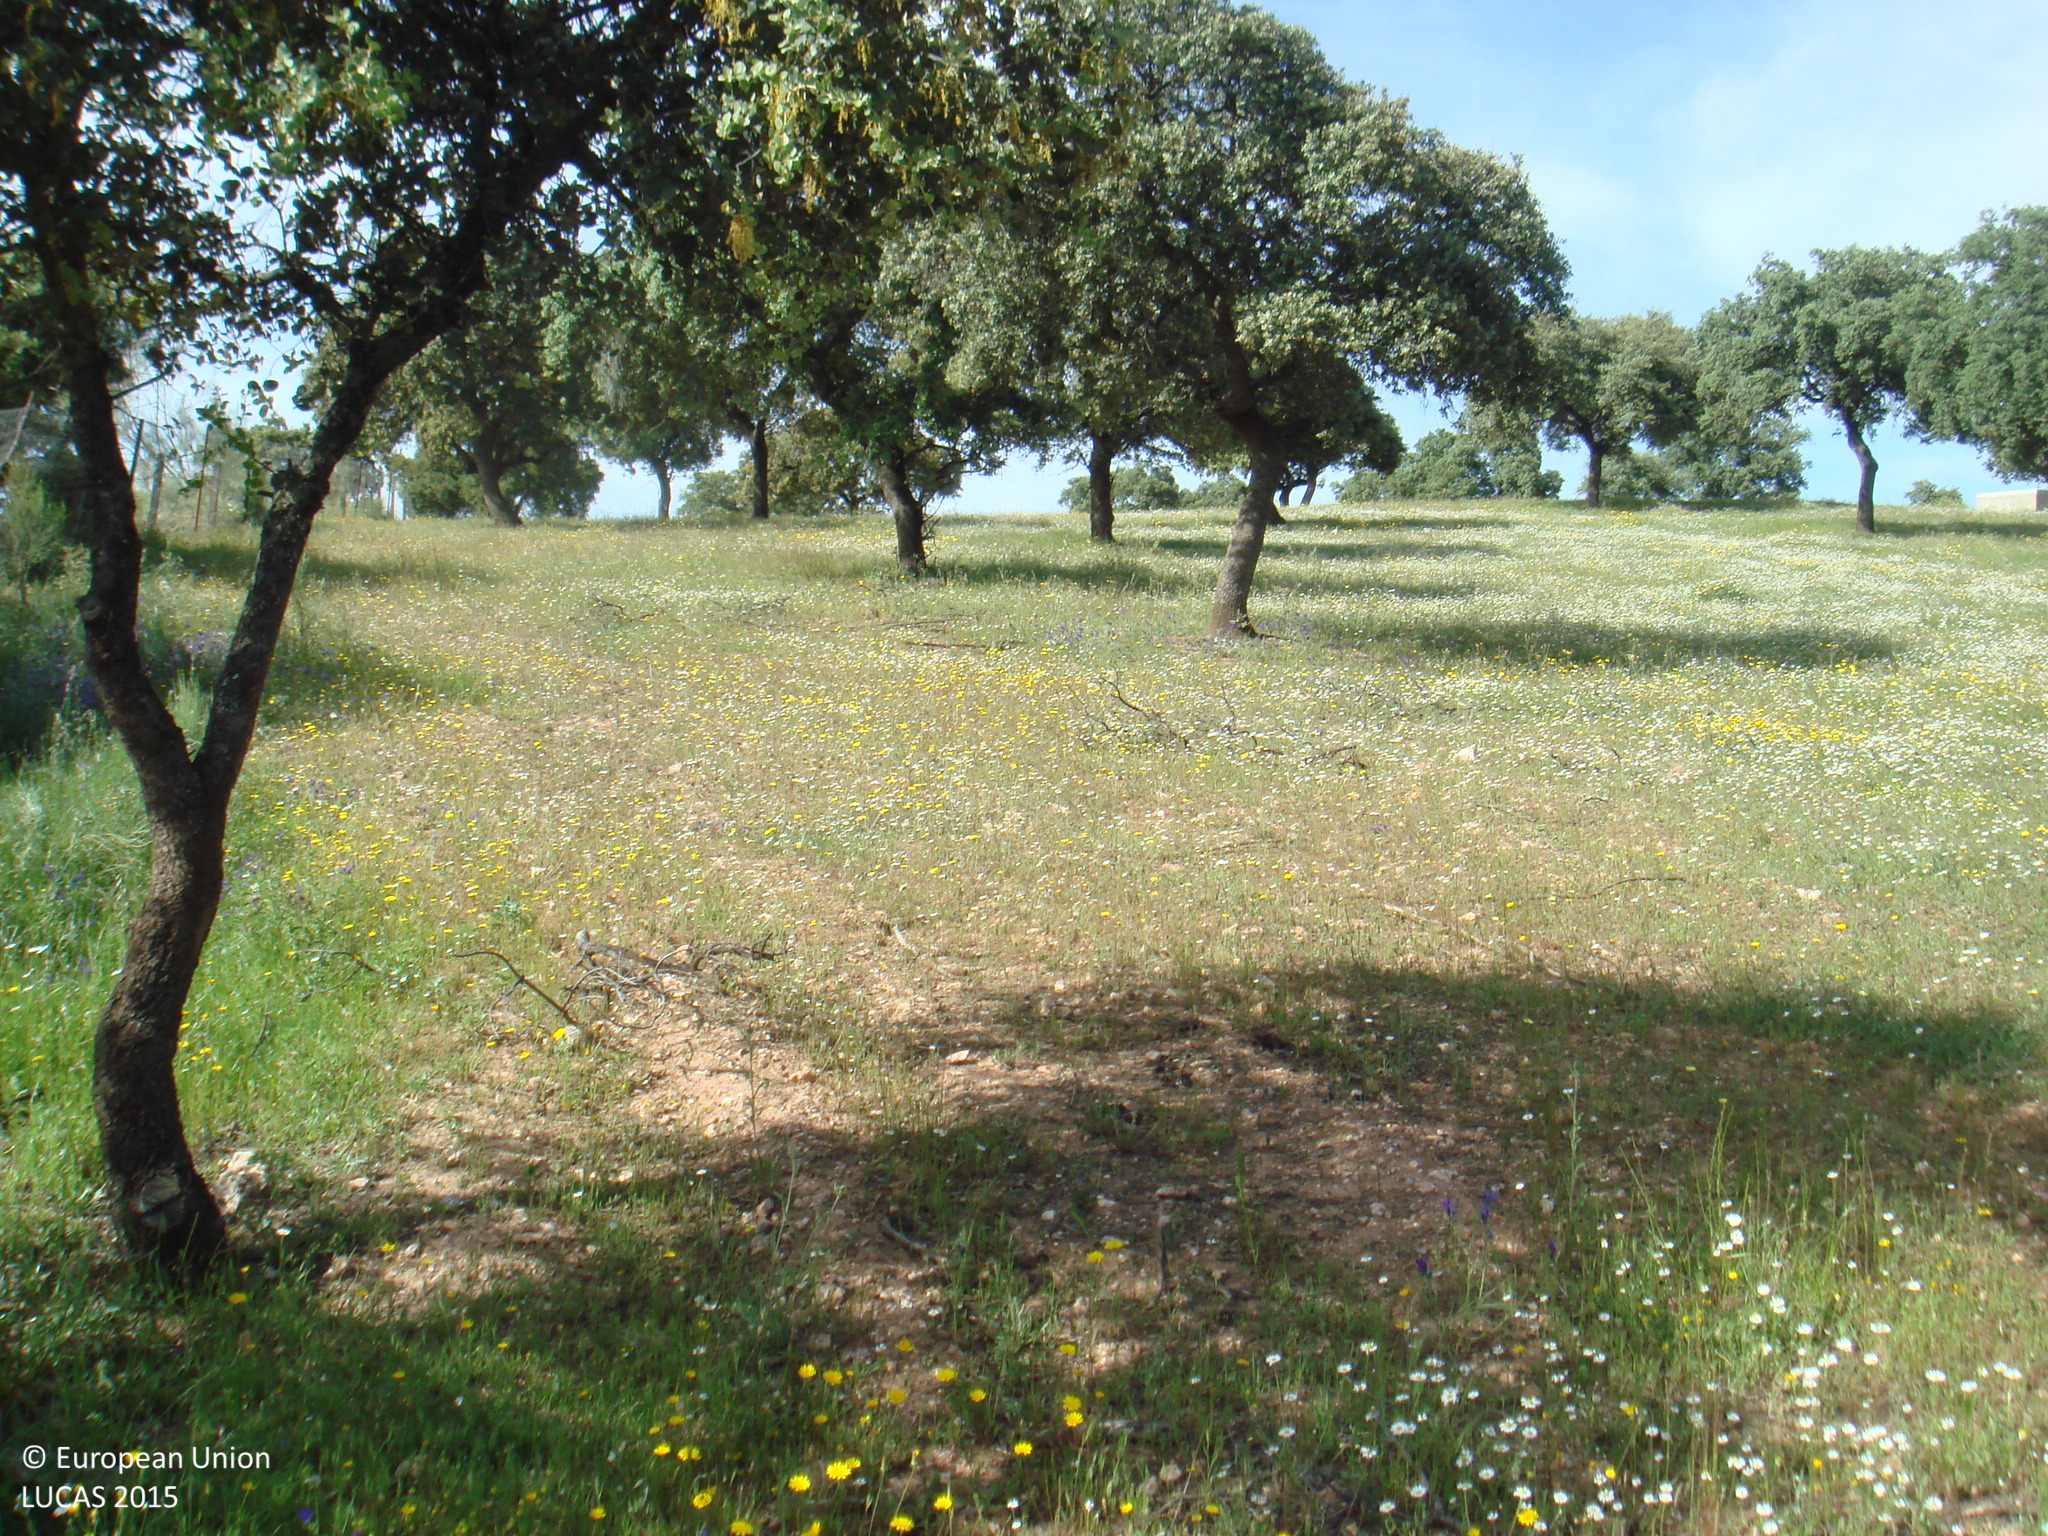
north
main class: Woodland
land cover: Broadleaved woodland
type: broadleaved evergreen forest
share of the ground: 10 - 25 %
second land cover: Oats
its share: > 75 %
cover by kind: herbaceous plants 85 %, broadleaved forest trees 15 %
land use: Forestry
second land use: Agriculture (excluding fallow land and kitchen gardens)
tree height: > 5 m
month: April
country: ES
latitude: 38.4094
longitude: -5.1101
